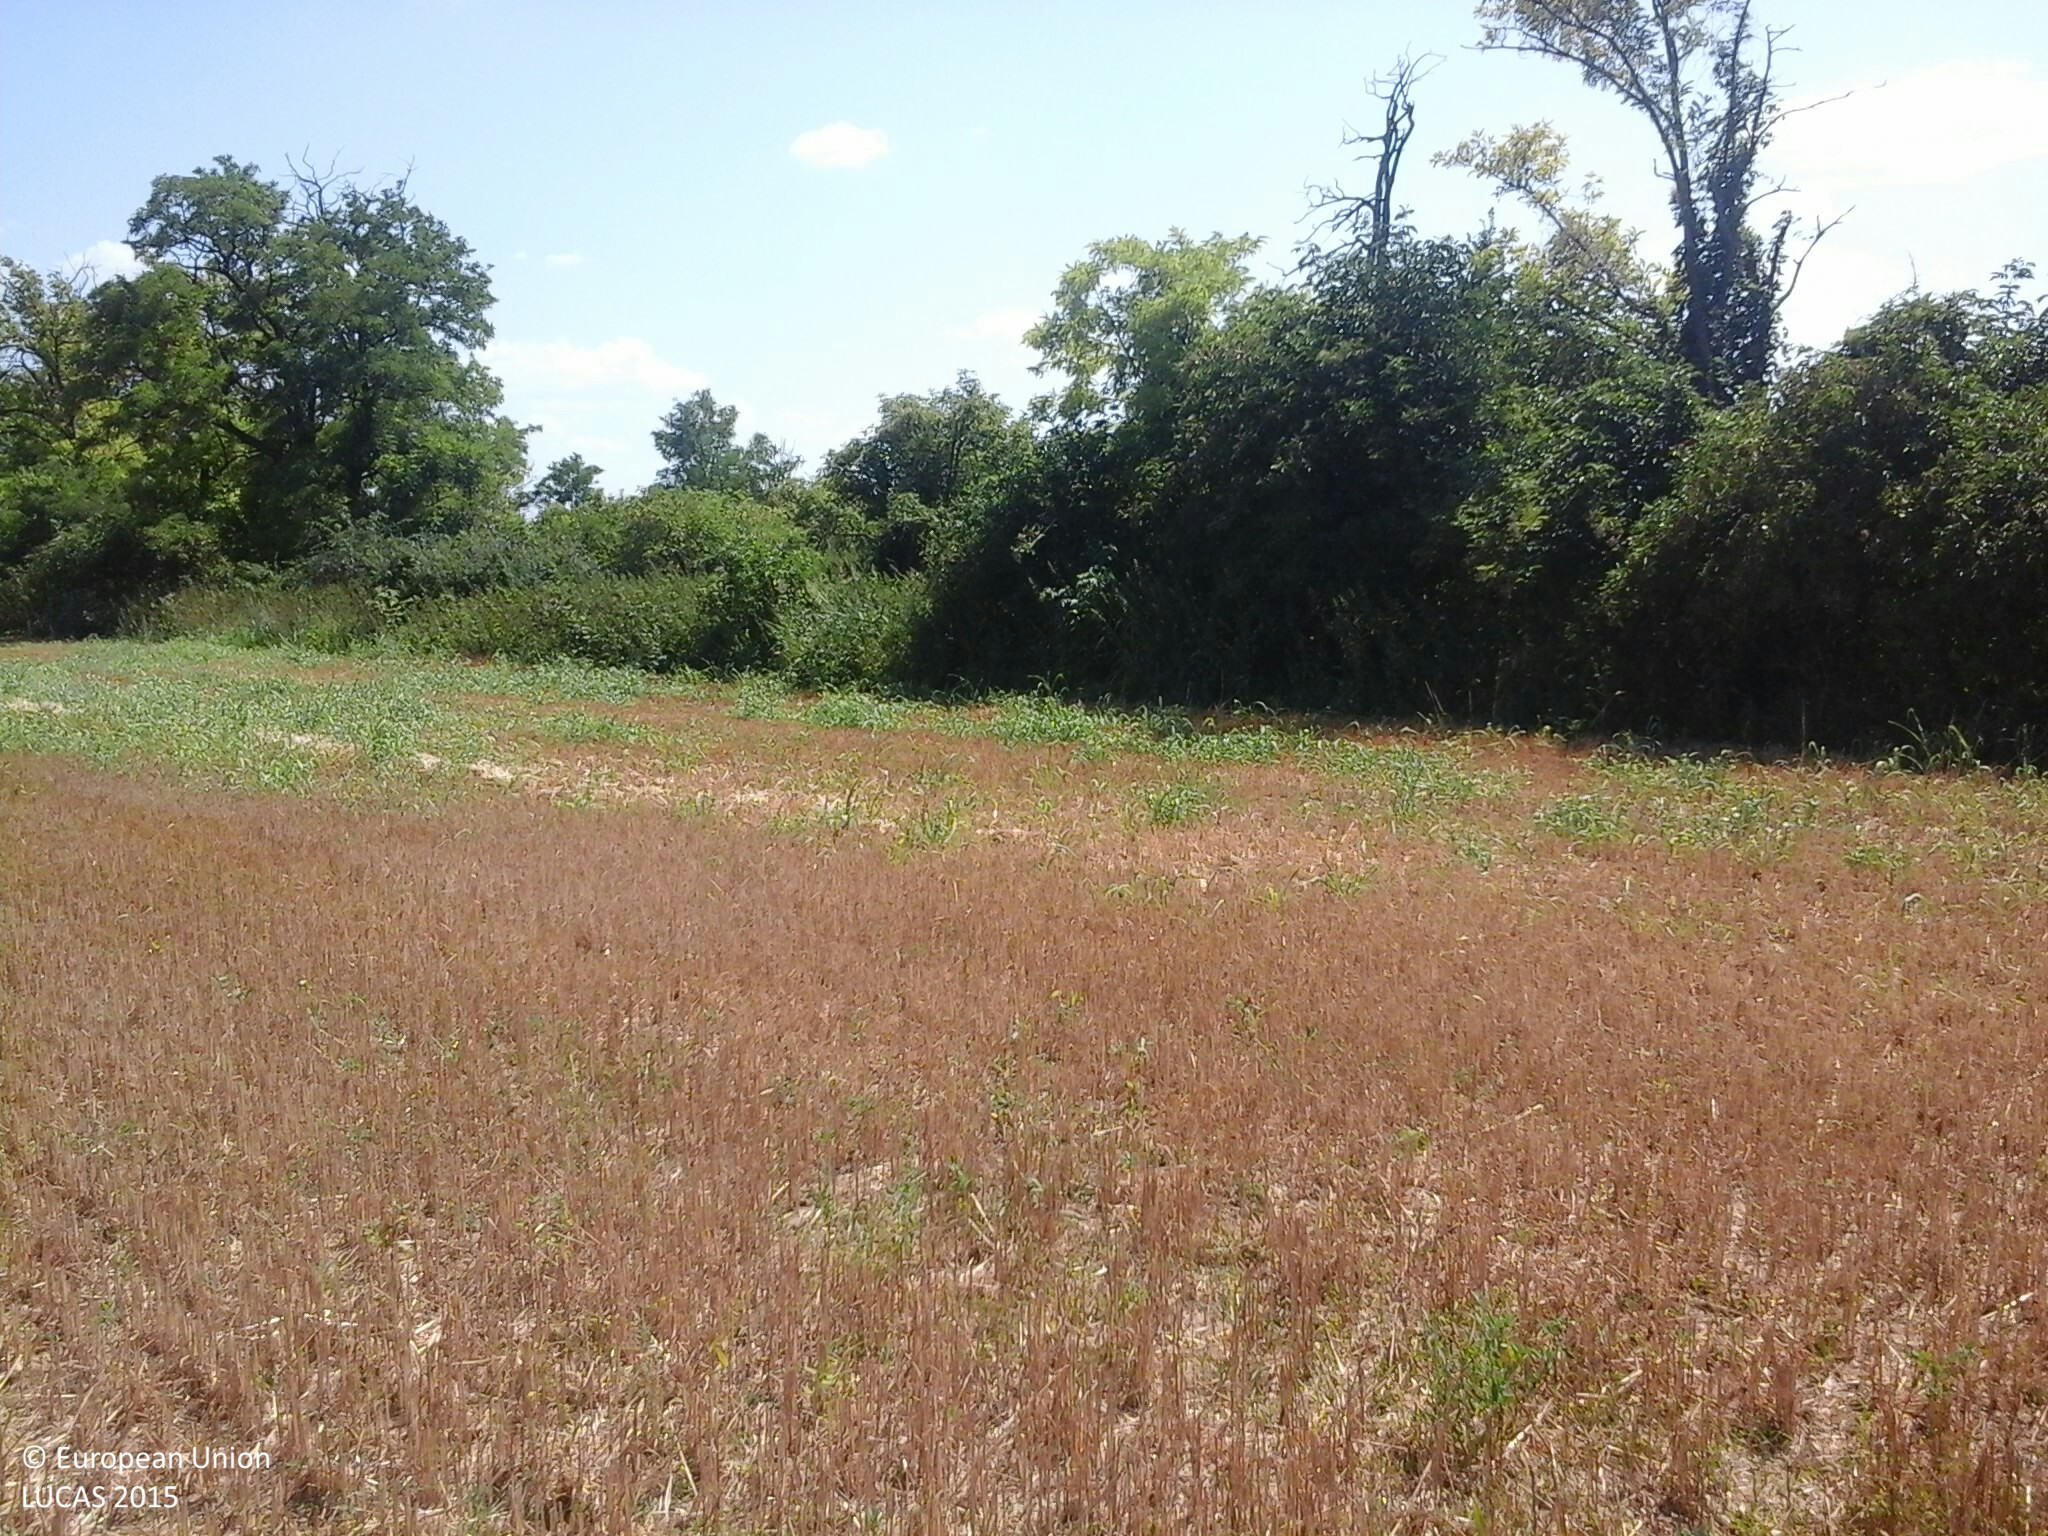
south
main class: Cropland
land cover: Common wheat
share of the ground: 25 - 50 %
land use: Agriculture (excluding fallow land and kitchen gardens)
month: July
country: HU
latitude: 47.0406
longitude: 18.3158
